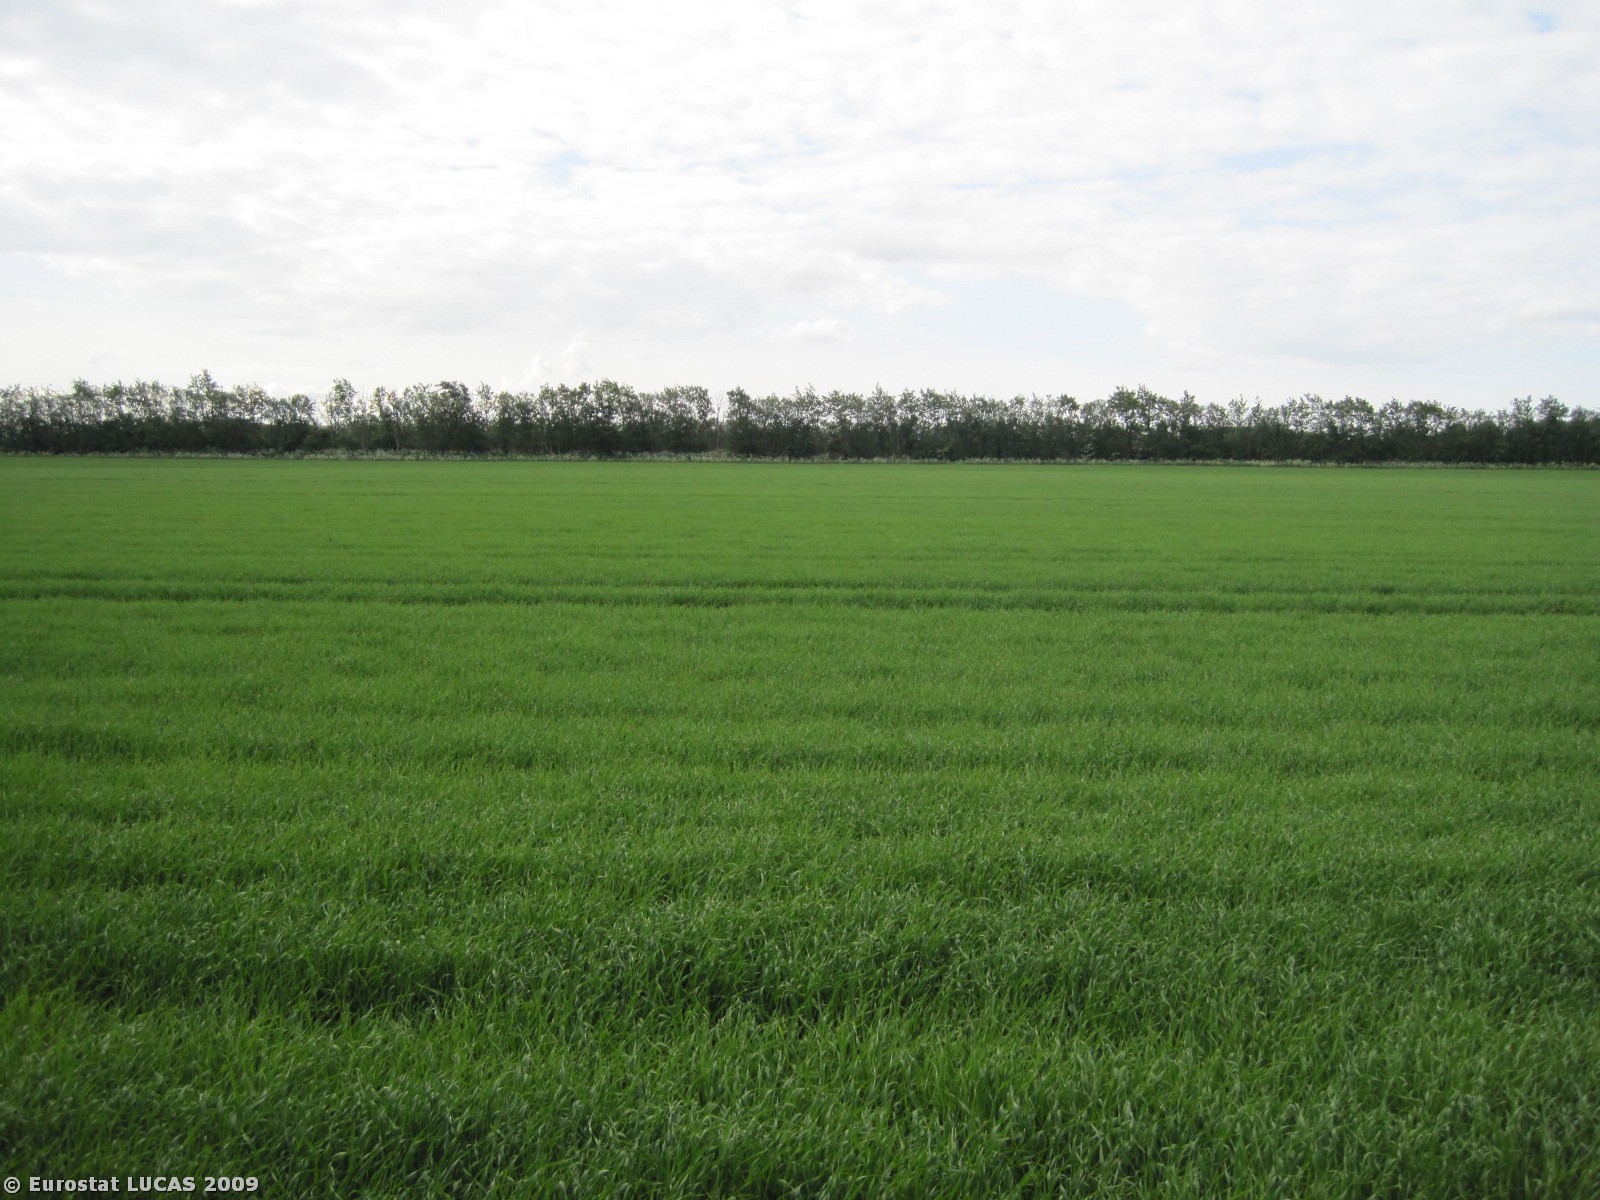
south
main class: Woodland
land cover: Broadleaved woodland
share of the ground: > 75 %
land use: Agriculture (excluding fallow land and kitchen gardens)
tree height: > 5 m
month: June
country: DK
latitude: 57.1943
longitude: 9.7852
